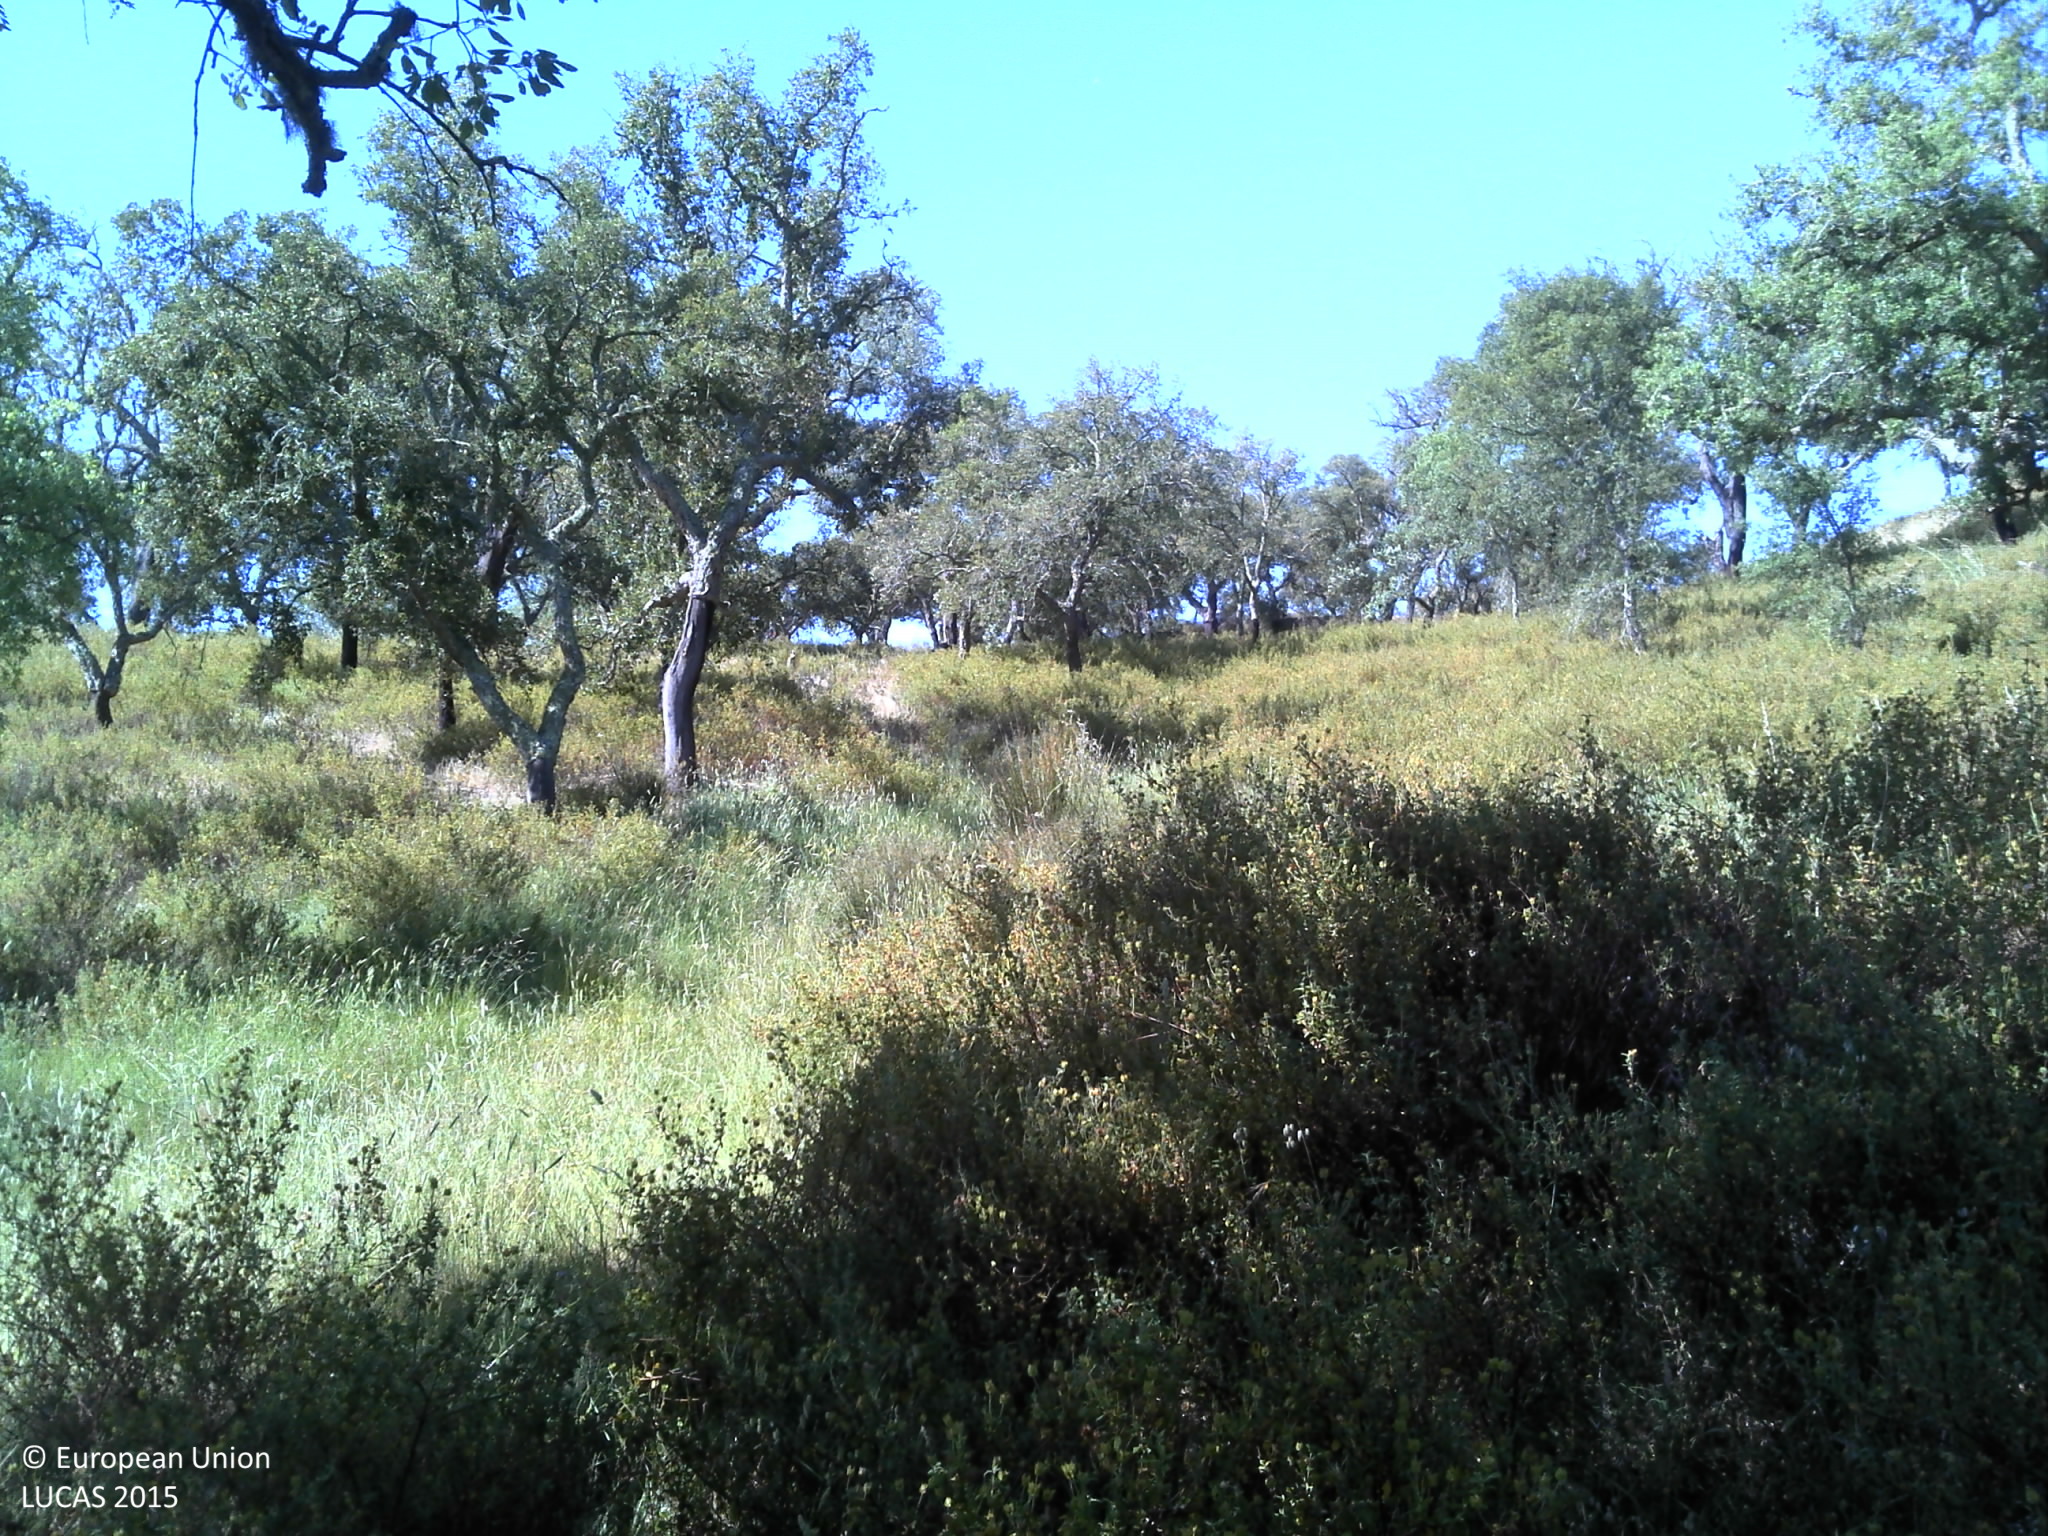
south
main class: Woodland
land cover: Broadleaved woodland
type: broadleaved evergreen forest
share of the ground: 25 - 50 %
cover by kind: shrubs 40 %, broadleaved forest trees 35 %, herbaceous plants 15 %, unconsolidated bare surface 10 %
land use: Forestry
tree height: > 5 m
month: May
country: PT
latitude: 38.0652
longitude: -8.5914
